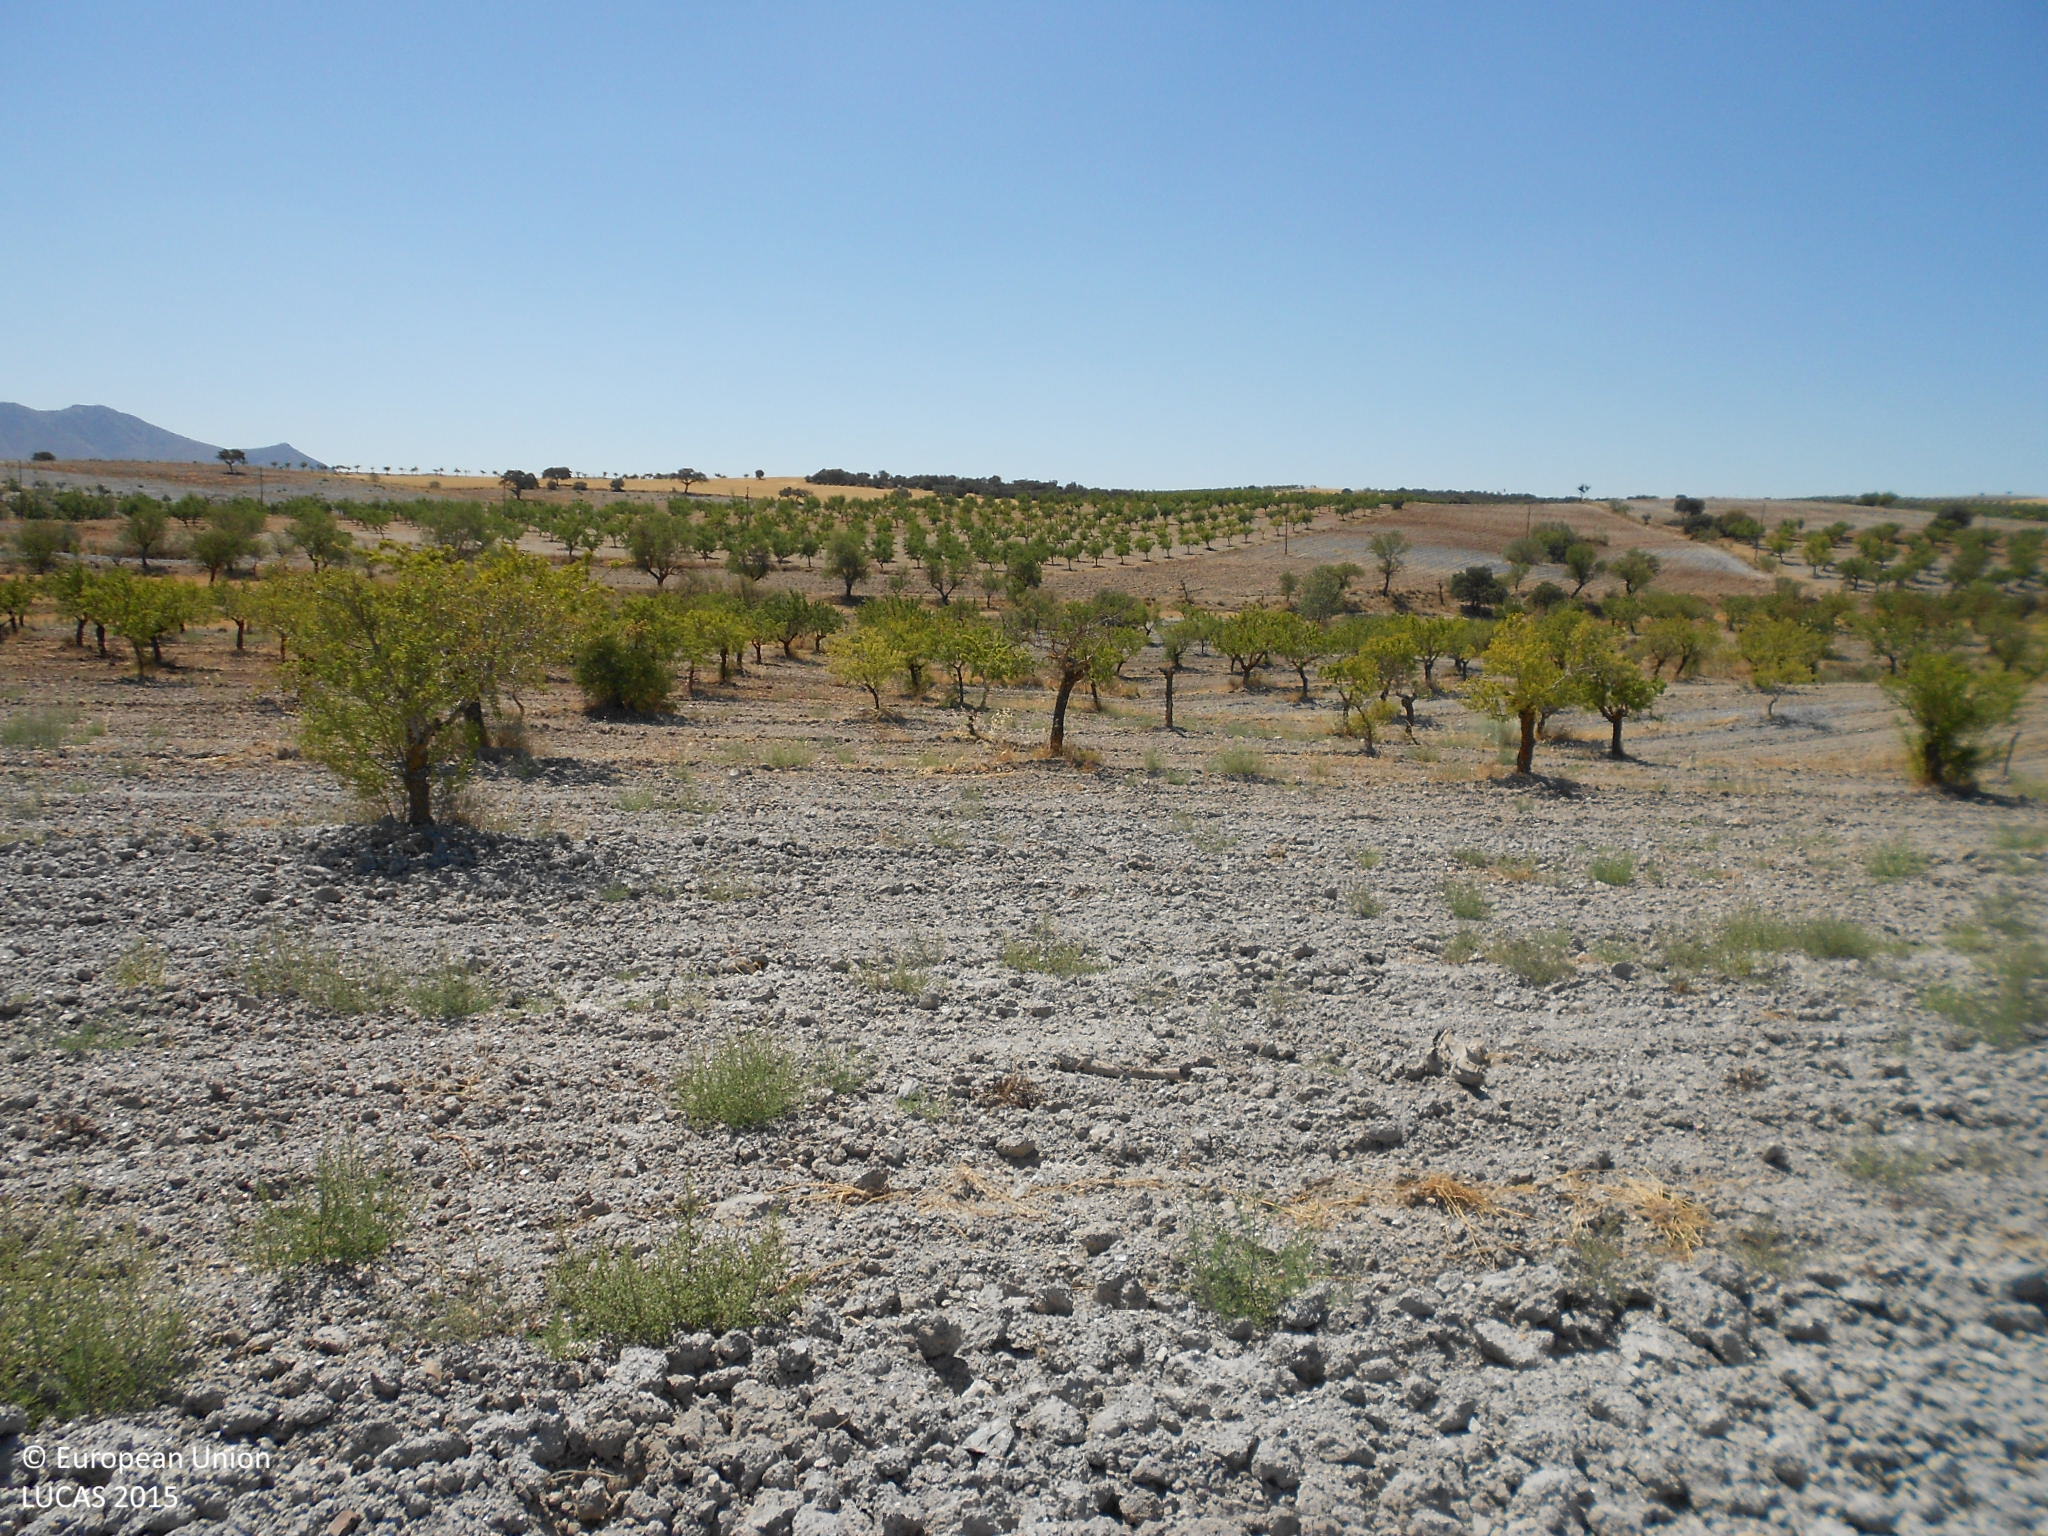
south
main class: Cropland
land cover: Nuts trees
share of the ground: < 10 %
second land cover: Other bare soil
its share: > 75 %
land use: Agriculture (excluding fallow land and kitchen gardens)
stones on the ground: > 50 %
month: July
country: ES
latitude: 37.5756
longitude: -2.2473
